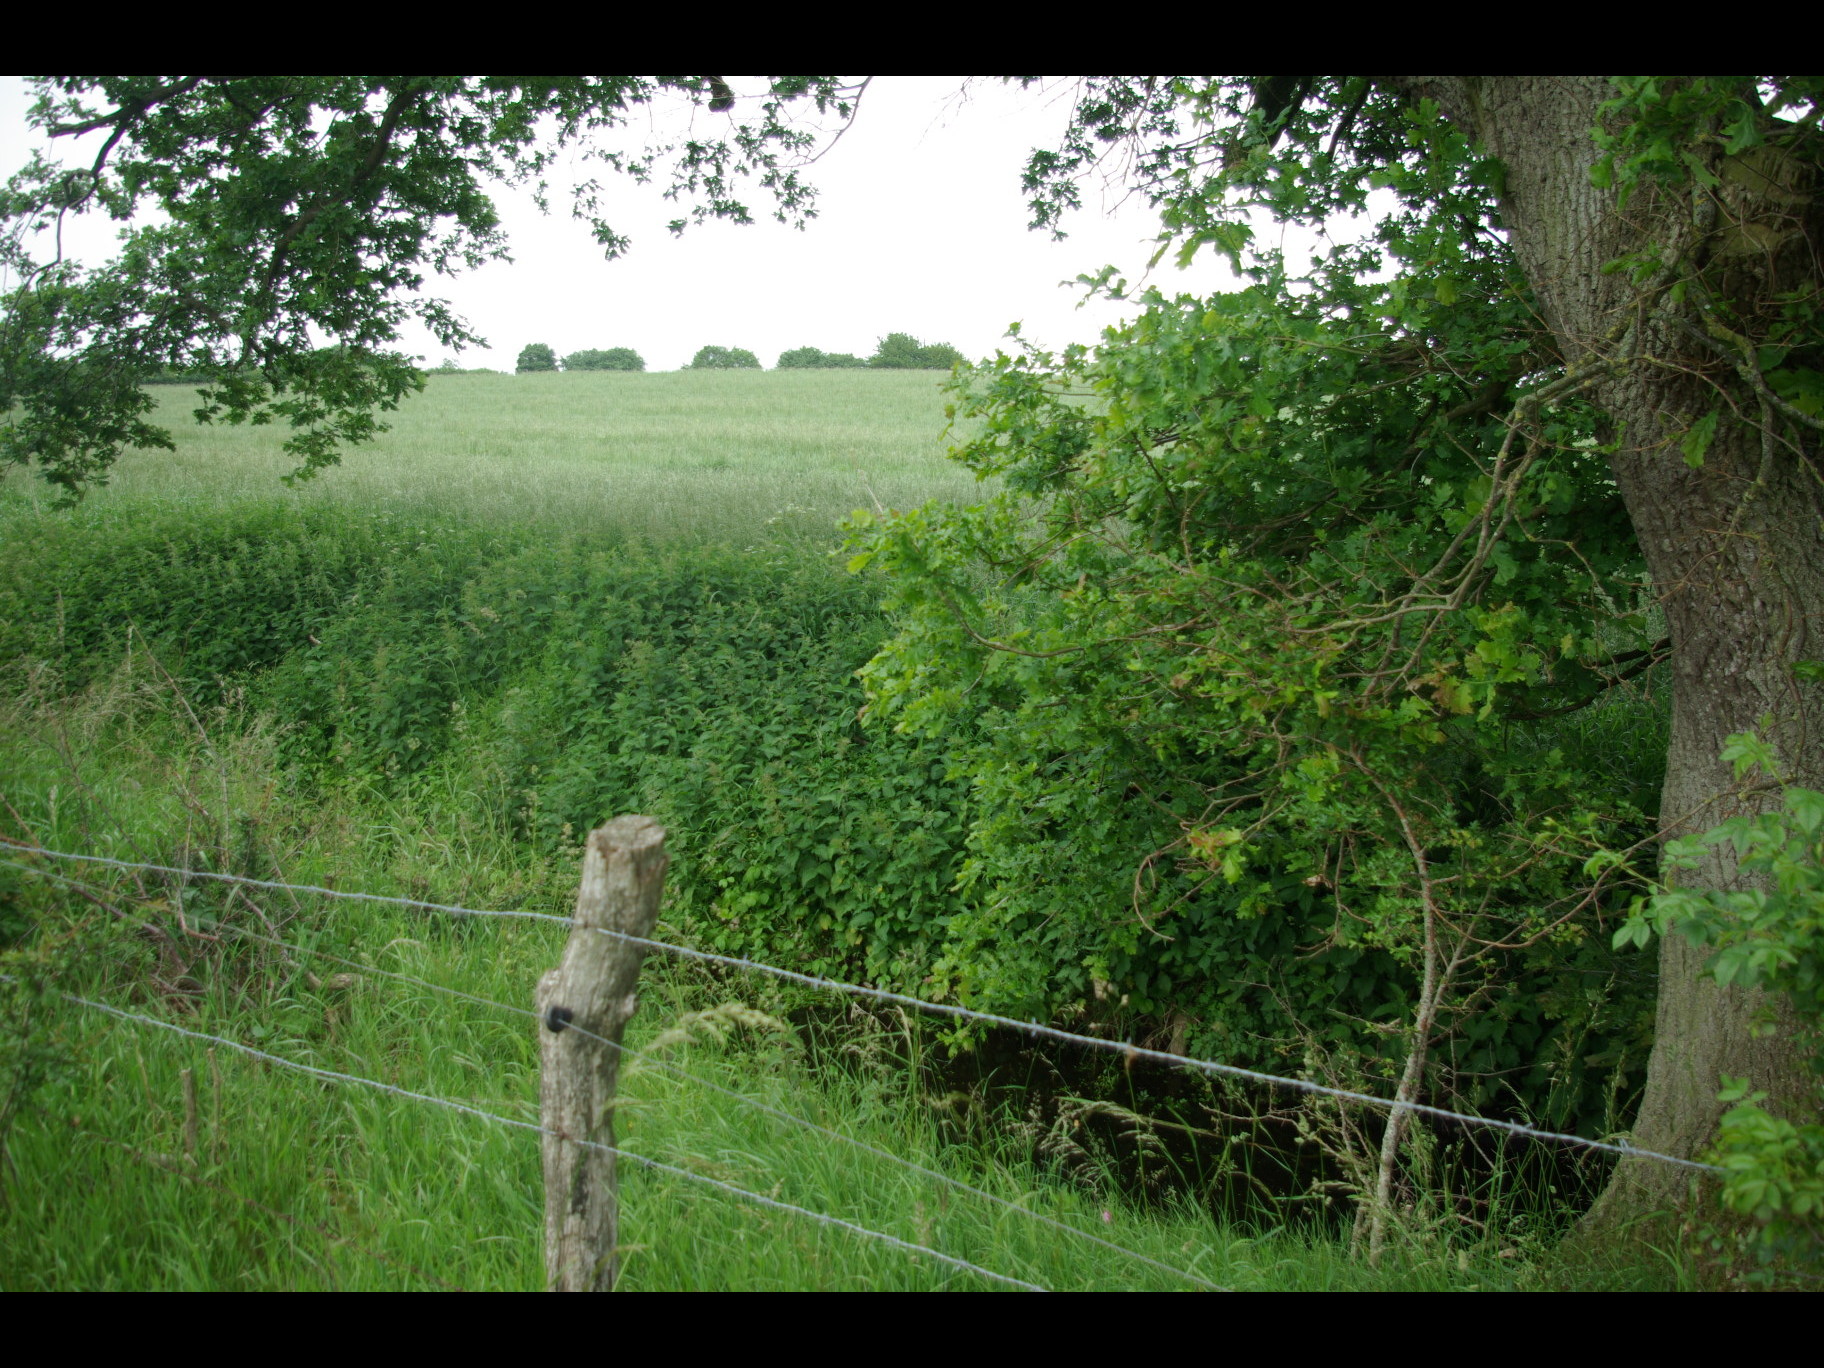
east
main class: Grassland
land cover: Grassland without tree/shrub cover
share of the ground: > 75 %
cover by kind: herbaceous plants 100 %
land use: Agriculture (excluding fallow land and kitchen gardens)
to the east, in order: Grassland without tree/shrub cover; Fences; Shruby margins; Single bushes/trees; Inland fresh running water; Shruby margins; Common wheat
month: June
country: DE
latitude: 54.5341
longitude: 9.8919
